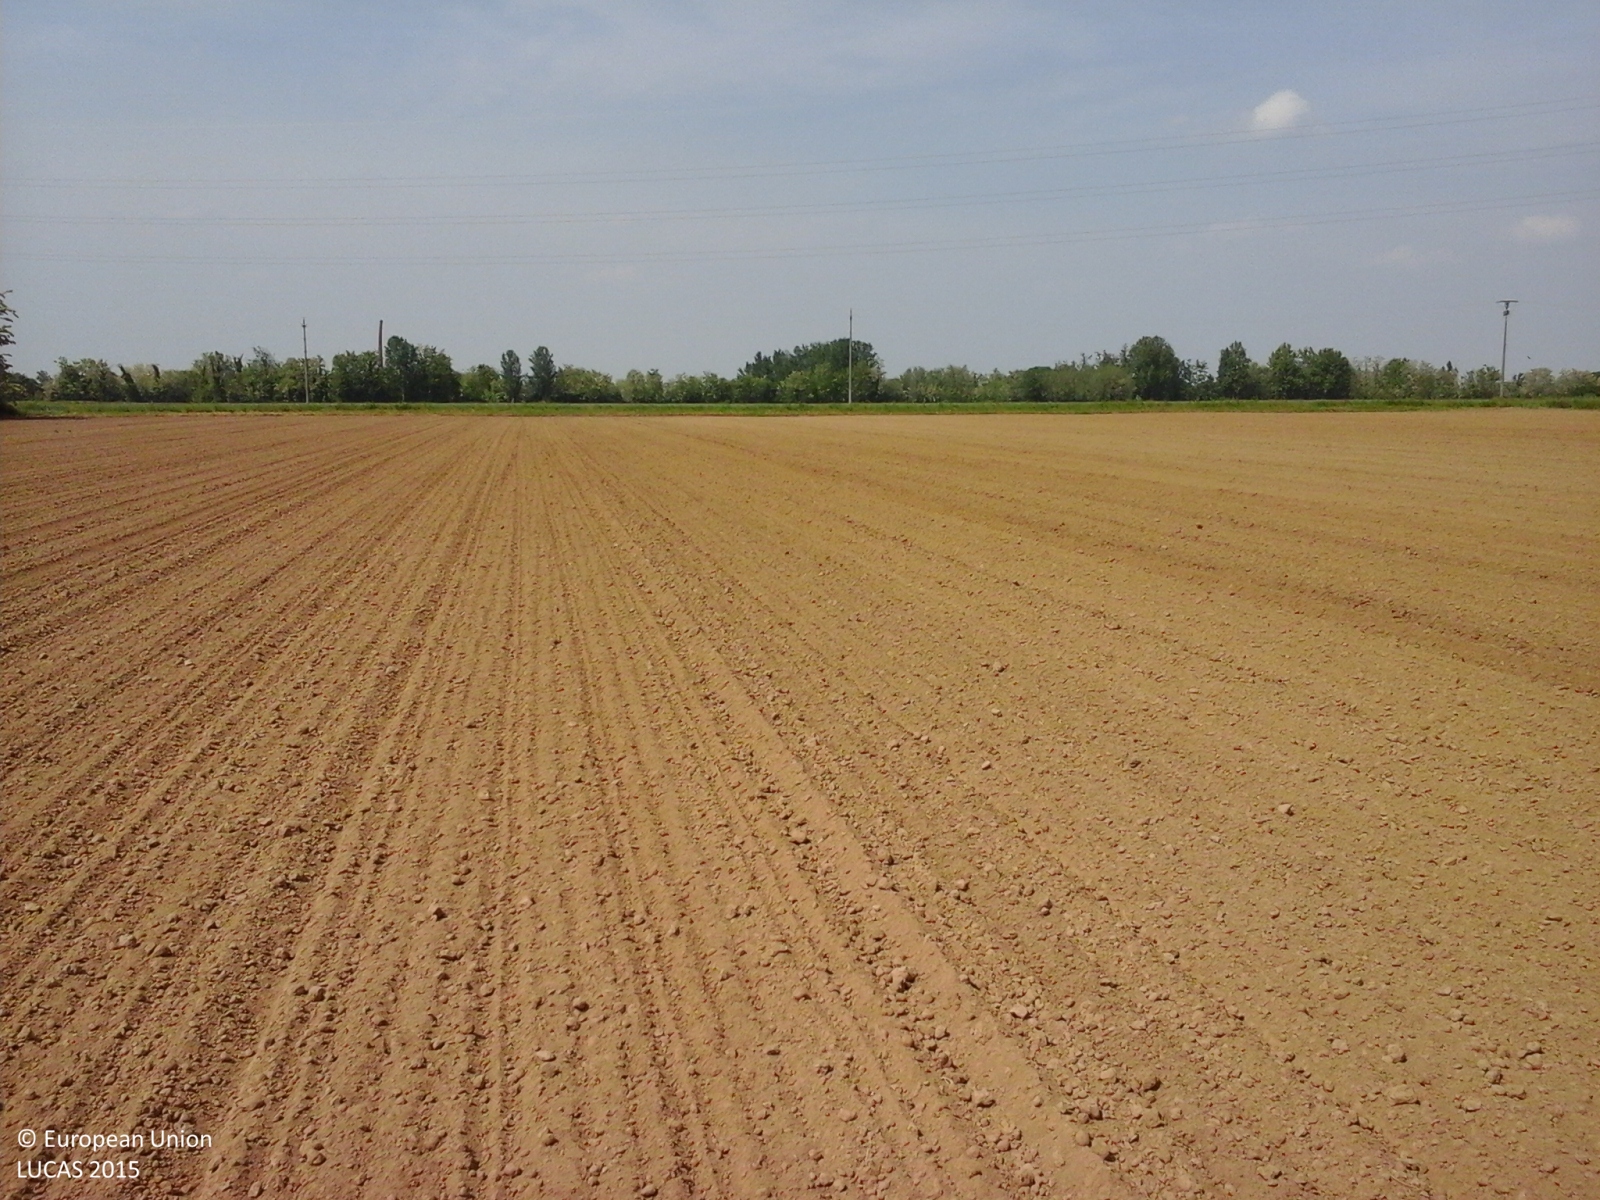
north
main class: Cropland
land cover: Soya
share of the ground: < 10 %
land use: Agriculture (excluding fallow land and kitchen gardens)
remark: Tilled/Sowed
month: May
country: IT
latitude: 45.1799
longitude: 9.8603
